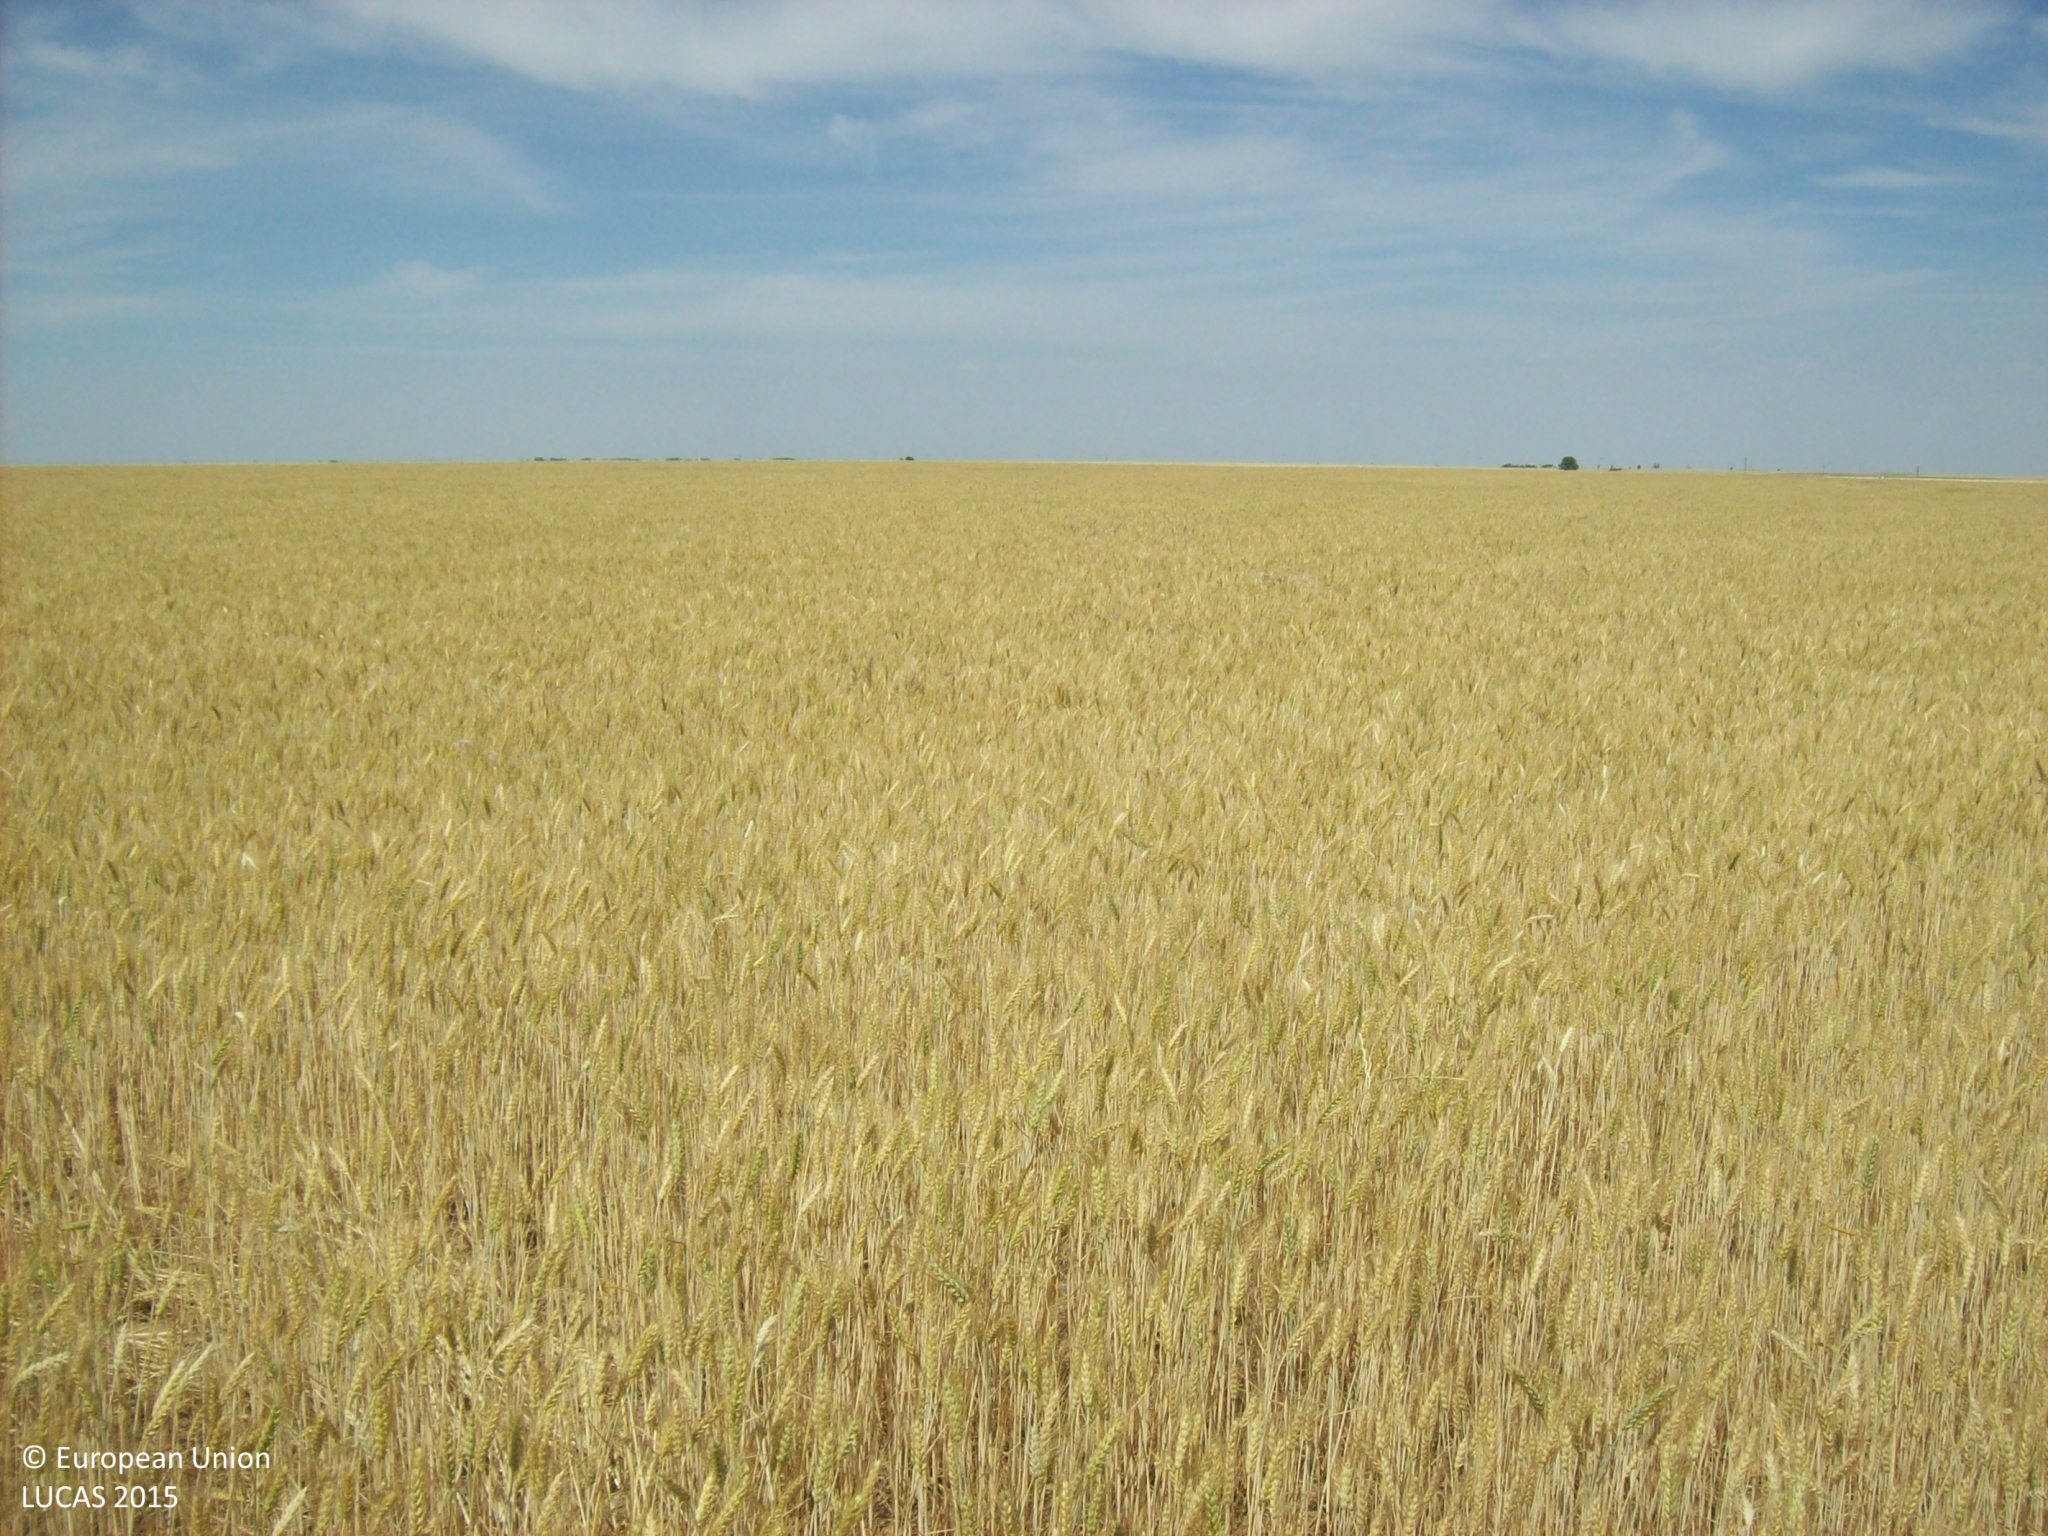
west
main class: Cropland
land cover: Common wheat
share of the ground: > 75 %
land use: Agriculture (excluding fallow land and kitchen gardens)
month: June
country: ES
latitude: 41.0531
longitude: -4.9981
